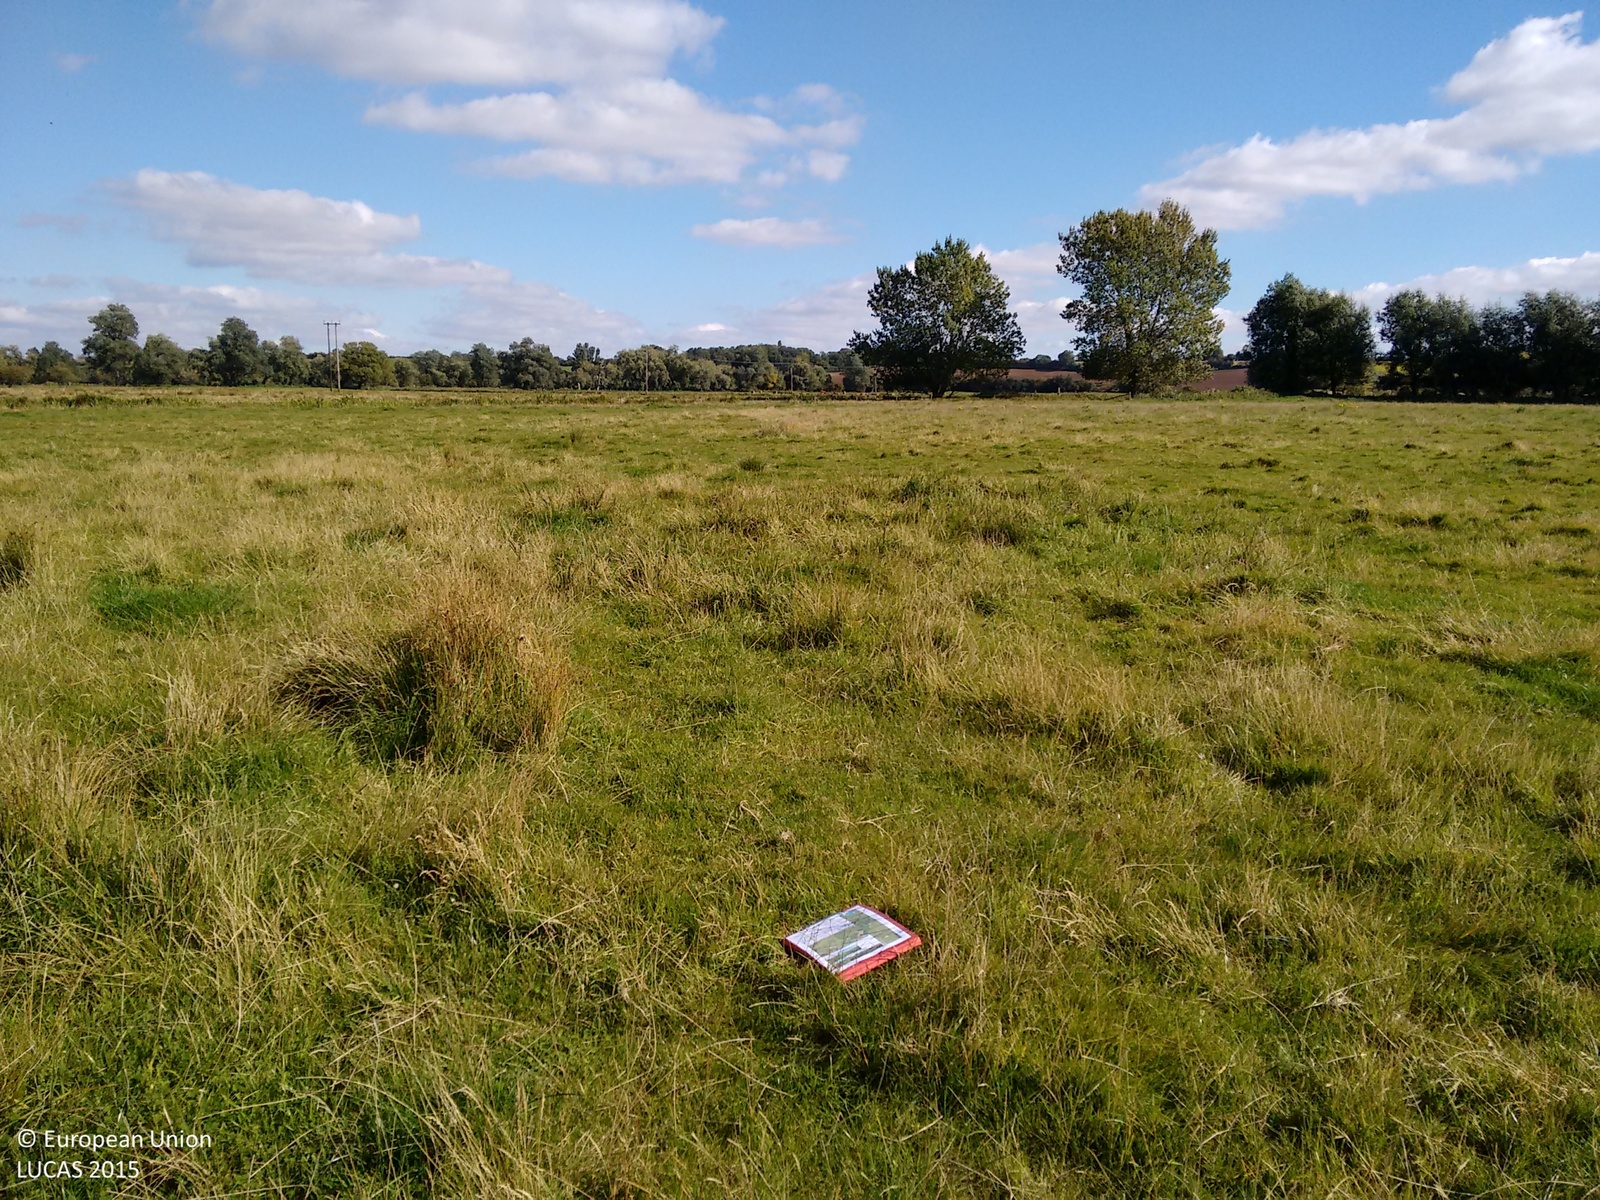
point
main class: Grassland
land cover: Grassland without tree/shrub cover
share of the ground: > 75 %
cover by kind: herbaceous plants 100 %
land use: Agriculture (excluding fallow land and kitchen gardens)
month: October
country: GB
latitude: 52.3850
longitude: 1.3257
